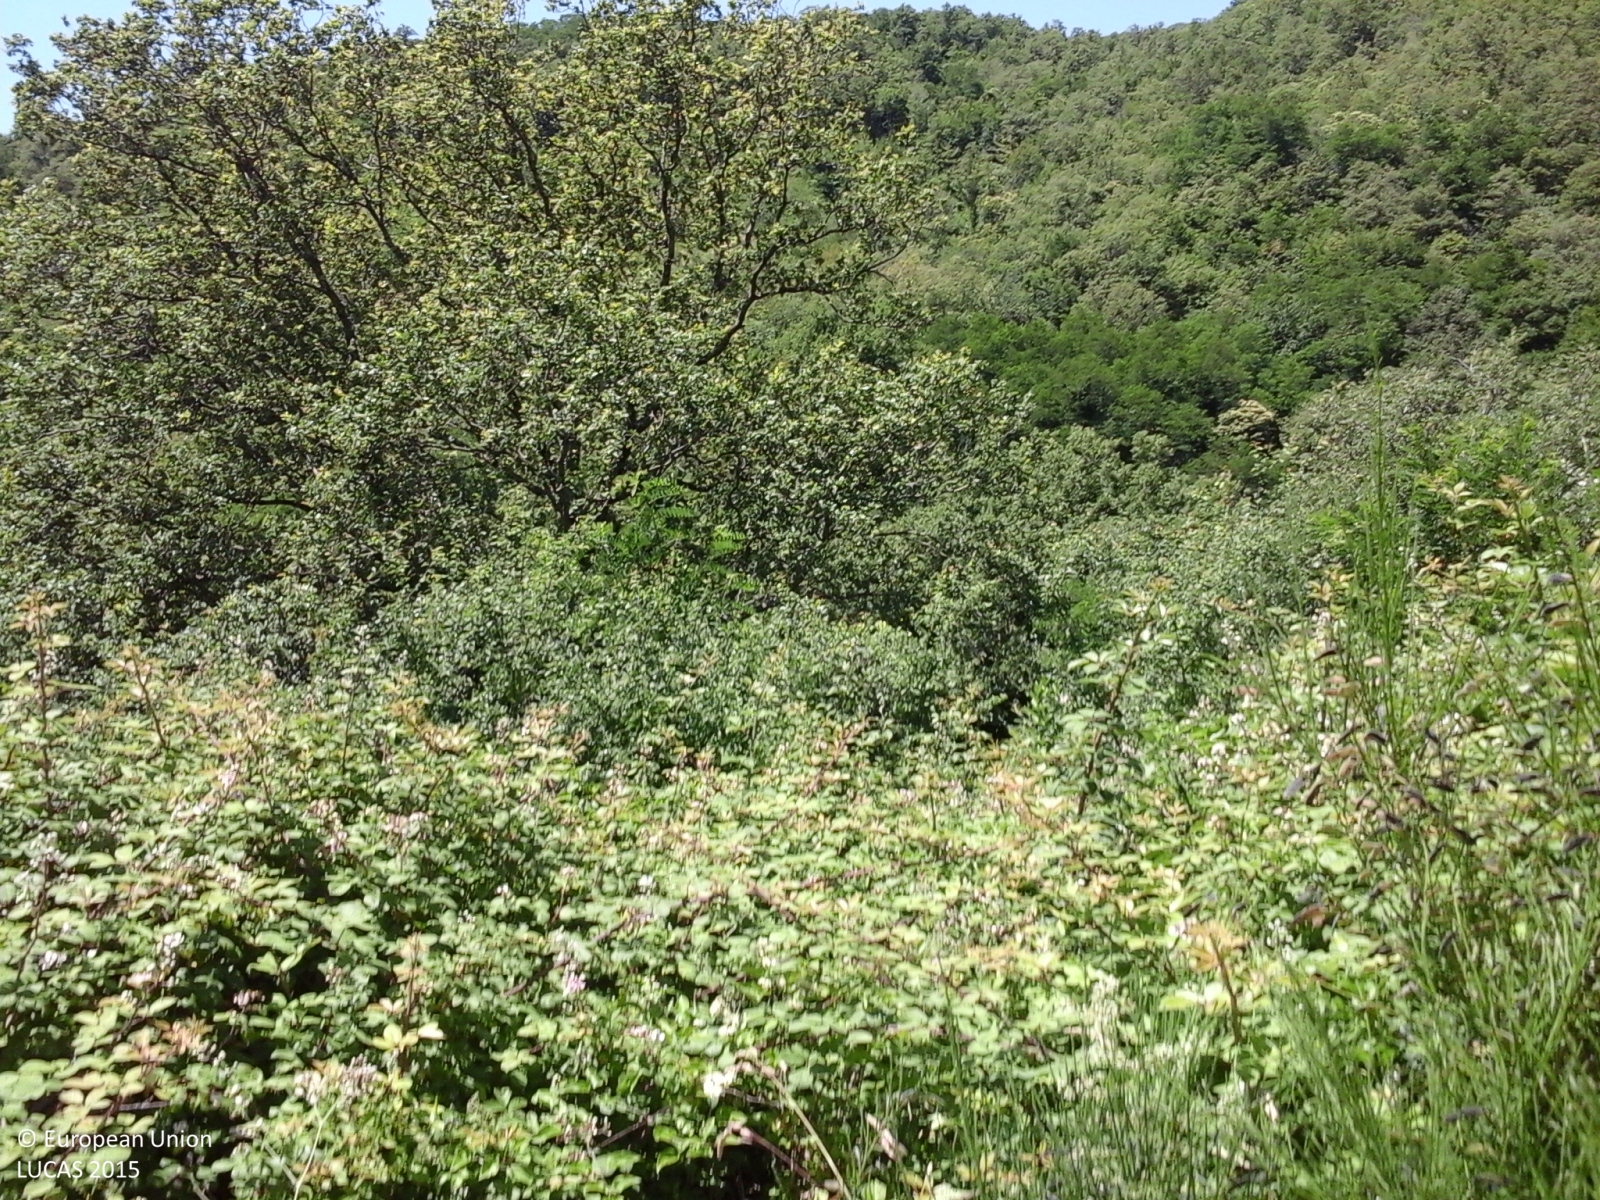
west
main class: Shrubland
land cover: Shrubland with sparse tree cover
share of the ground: > 75 %
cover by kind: shrubs 80 %, herbaceous plants 15 %, broadleaved forest trees 5 %
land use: Semi-natural and natural areas not in use
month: June
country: IT
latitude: 43.8691
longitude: 11.6012
